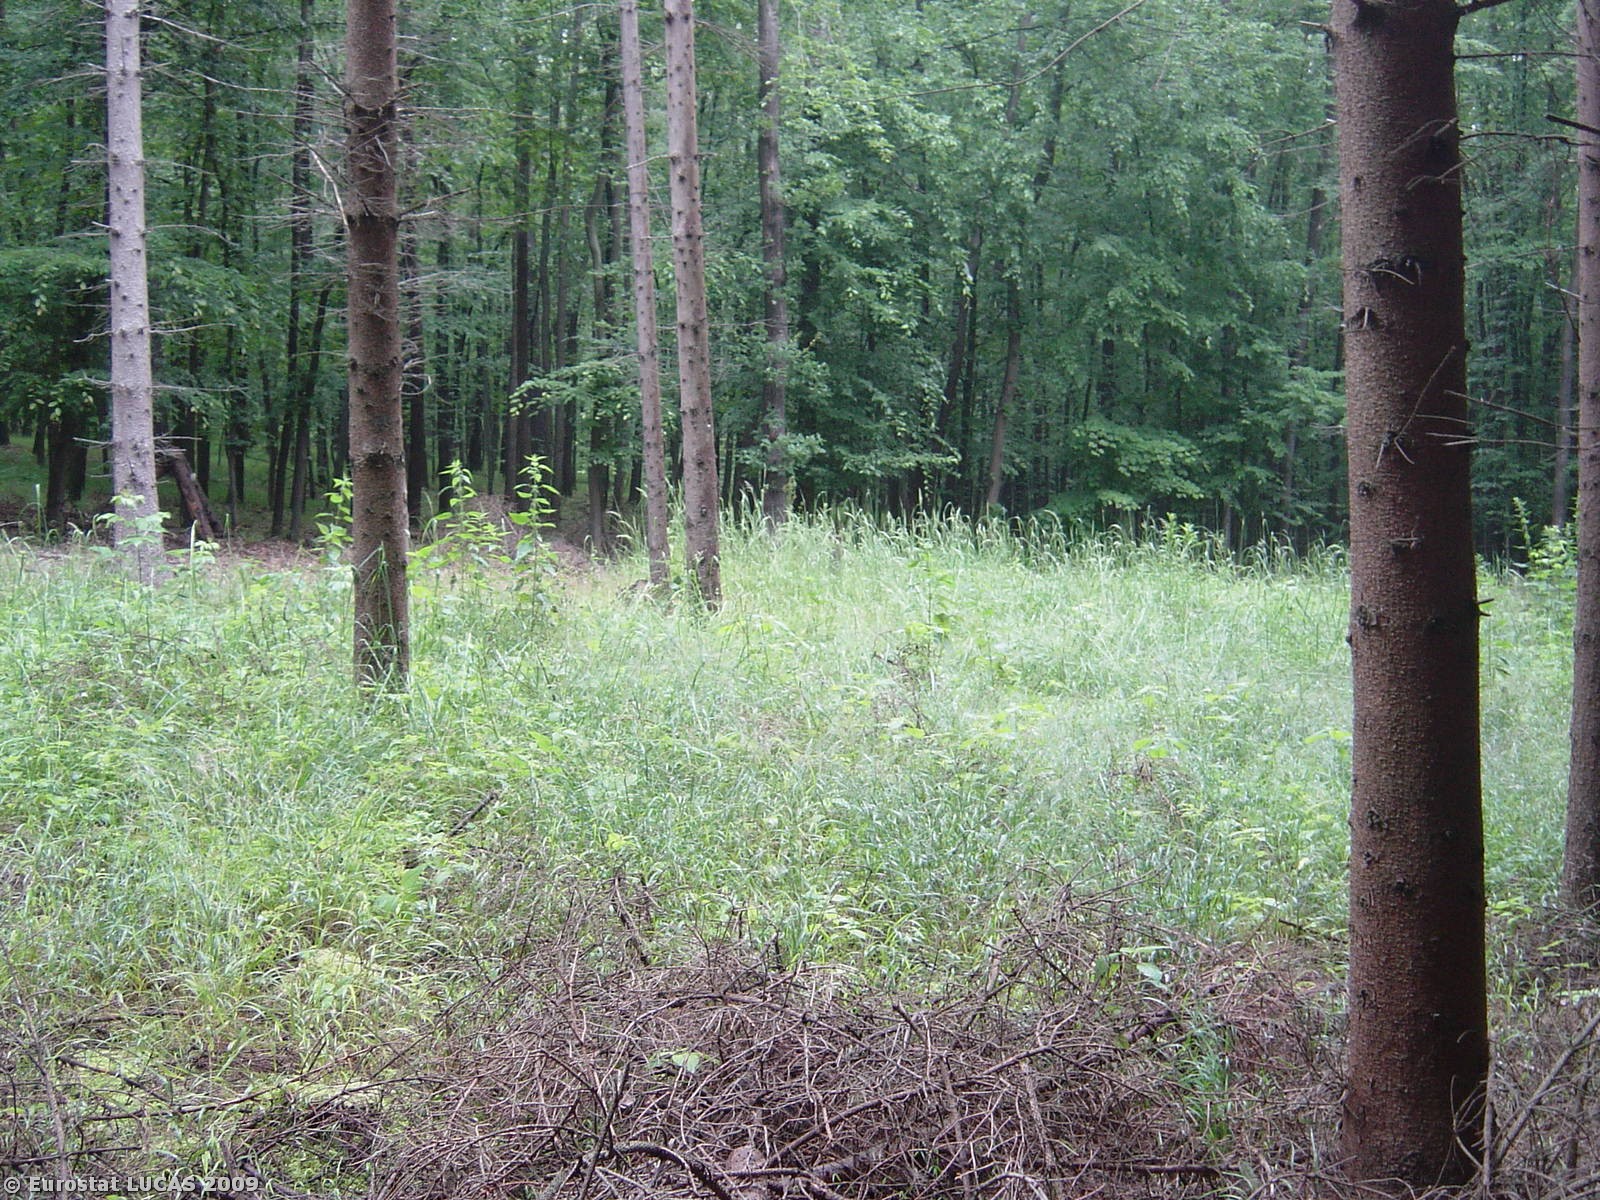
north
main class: Woodland
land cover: Coniferous woodland
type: hemiboreal forest and nemoral coniferous forest and mixed broadleaved-coniferous forest
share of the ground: > 75 %
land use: Forestry
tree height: > 5 m
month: June
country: CZ
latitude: 49.2382
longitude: 17.1381
